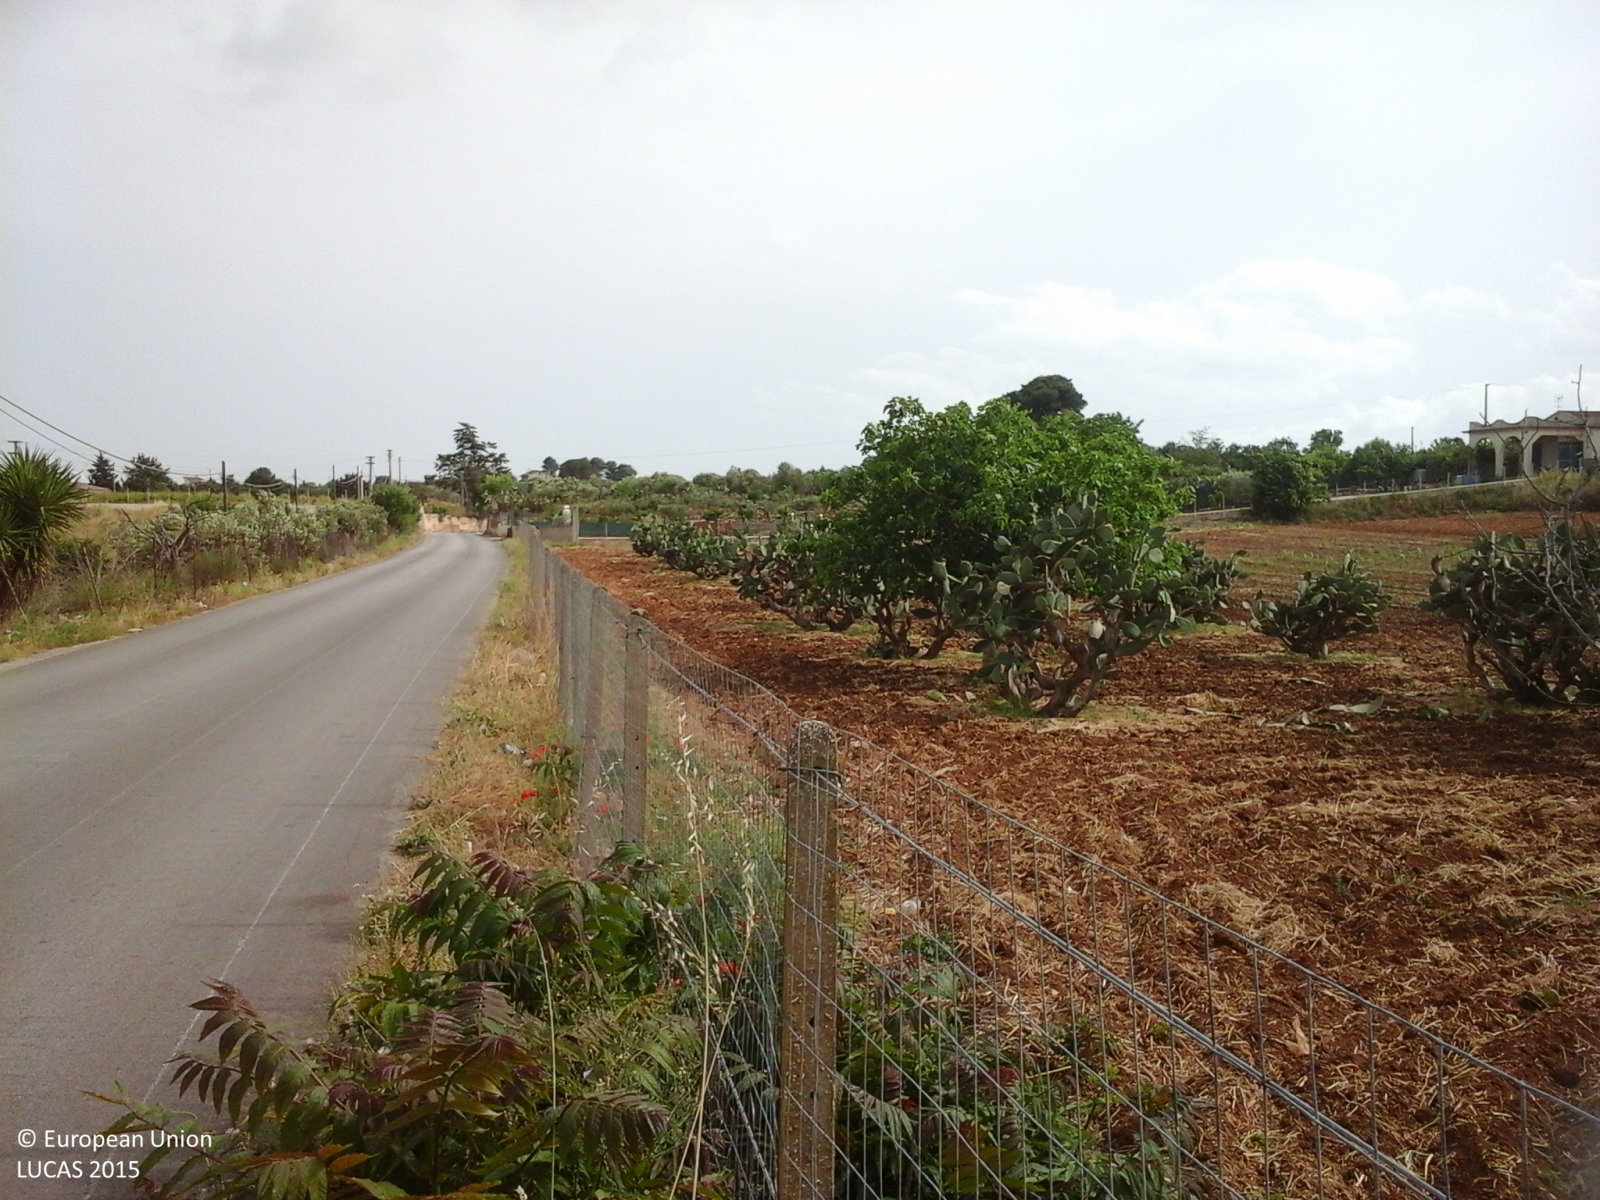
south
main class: Cropland
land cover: Olive groves
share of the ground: 50 - 75 %
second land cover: Other bare soil
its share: > 75 %
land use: Agriculture (excluding fallow land and kitchen gardens)
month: May
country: IT
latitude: 37.6819
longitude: 13.0049
